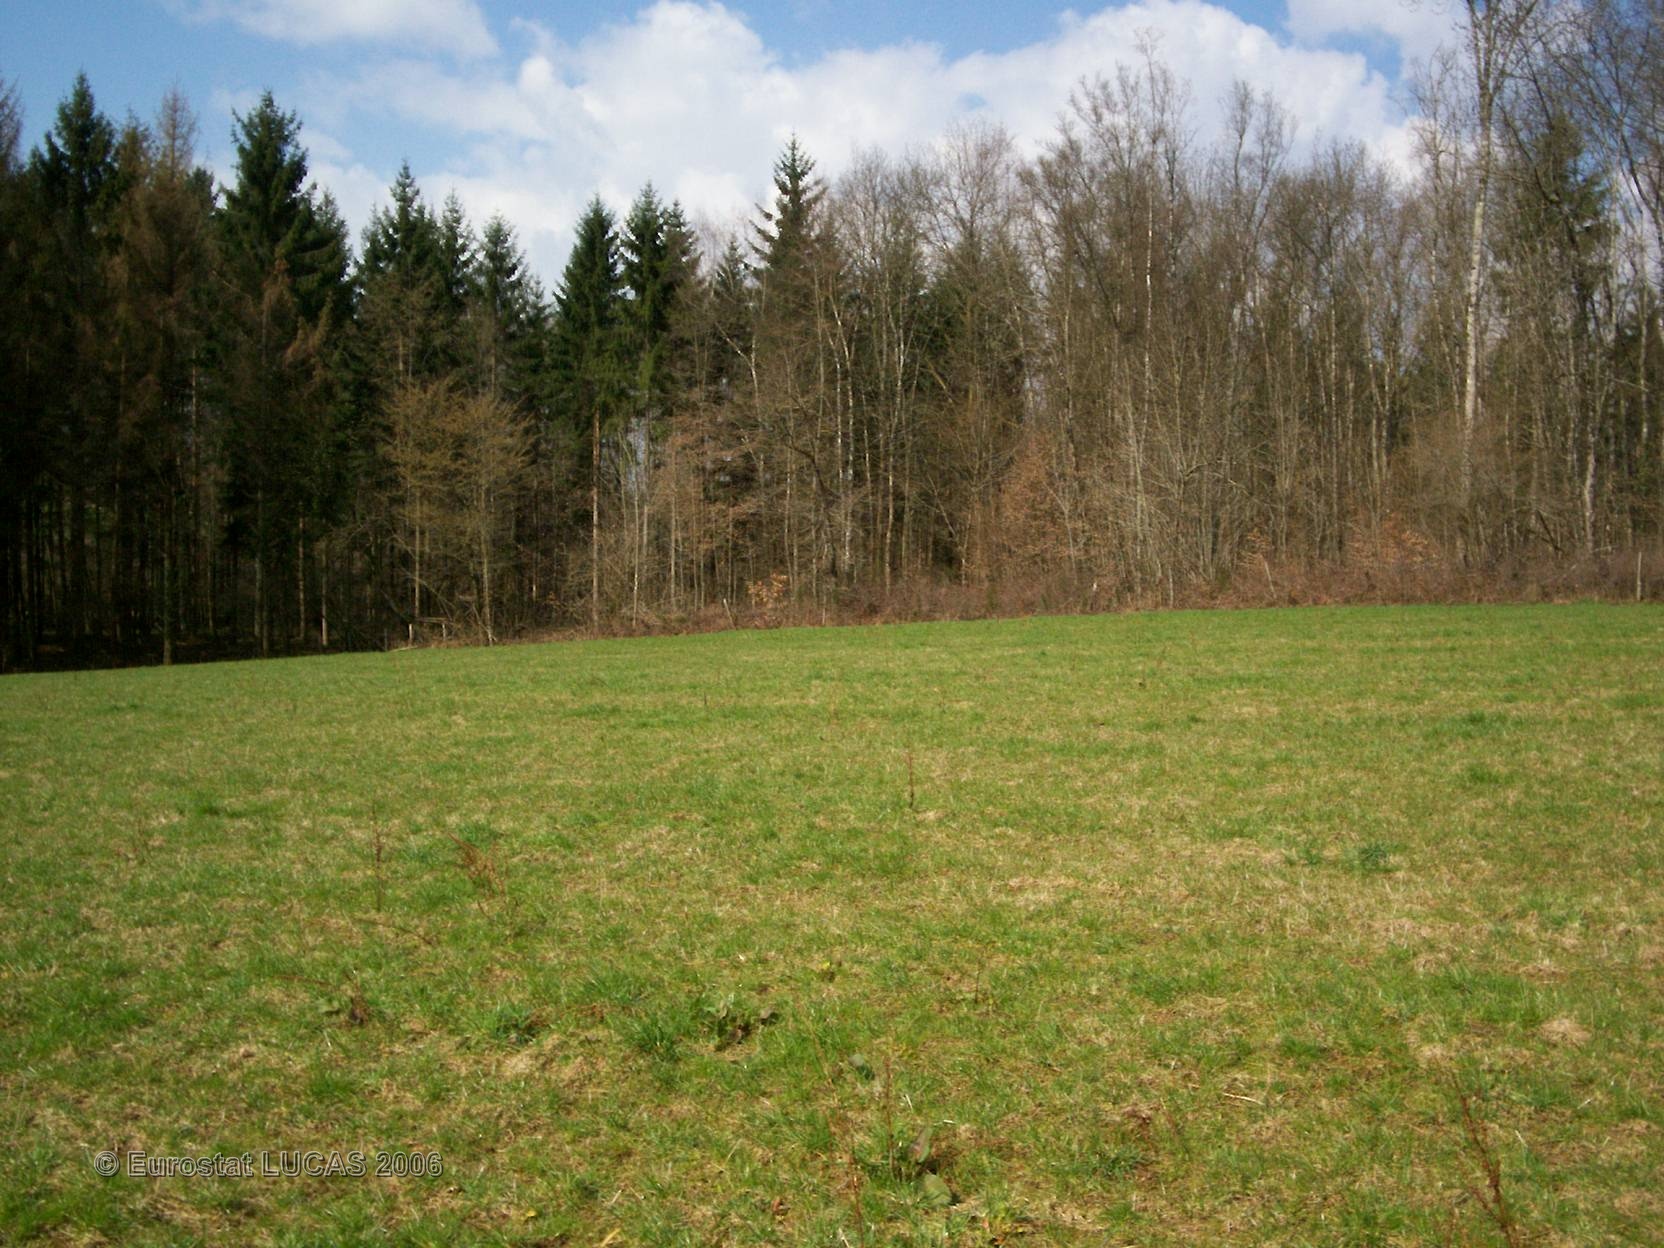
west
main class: Grassland
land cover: Grassland without tree/shrub cover
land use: Agriculture (excluding fallow land and kitchen gardens)
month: April
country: FR
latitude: 47.9262
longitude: 6.2669
